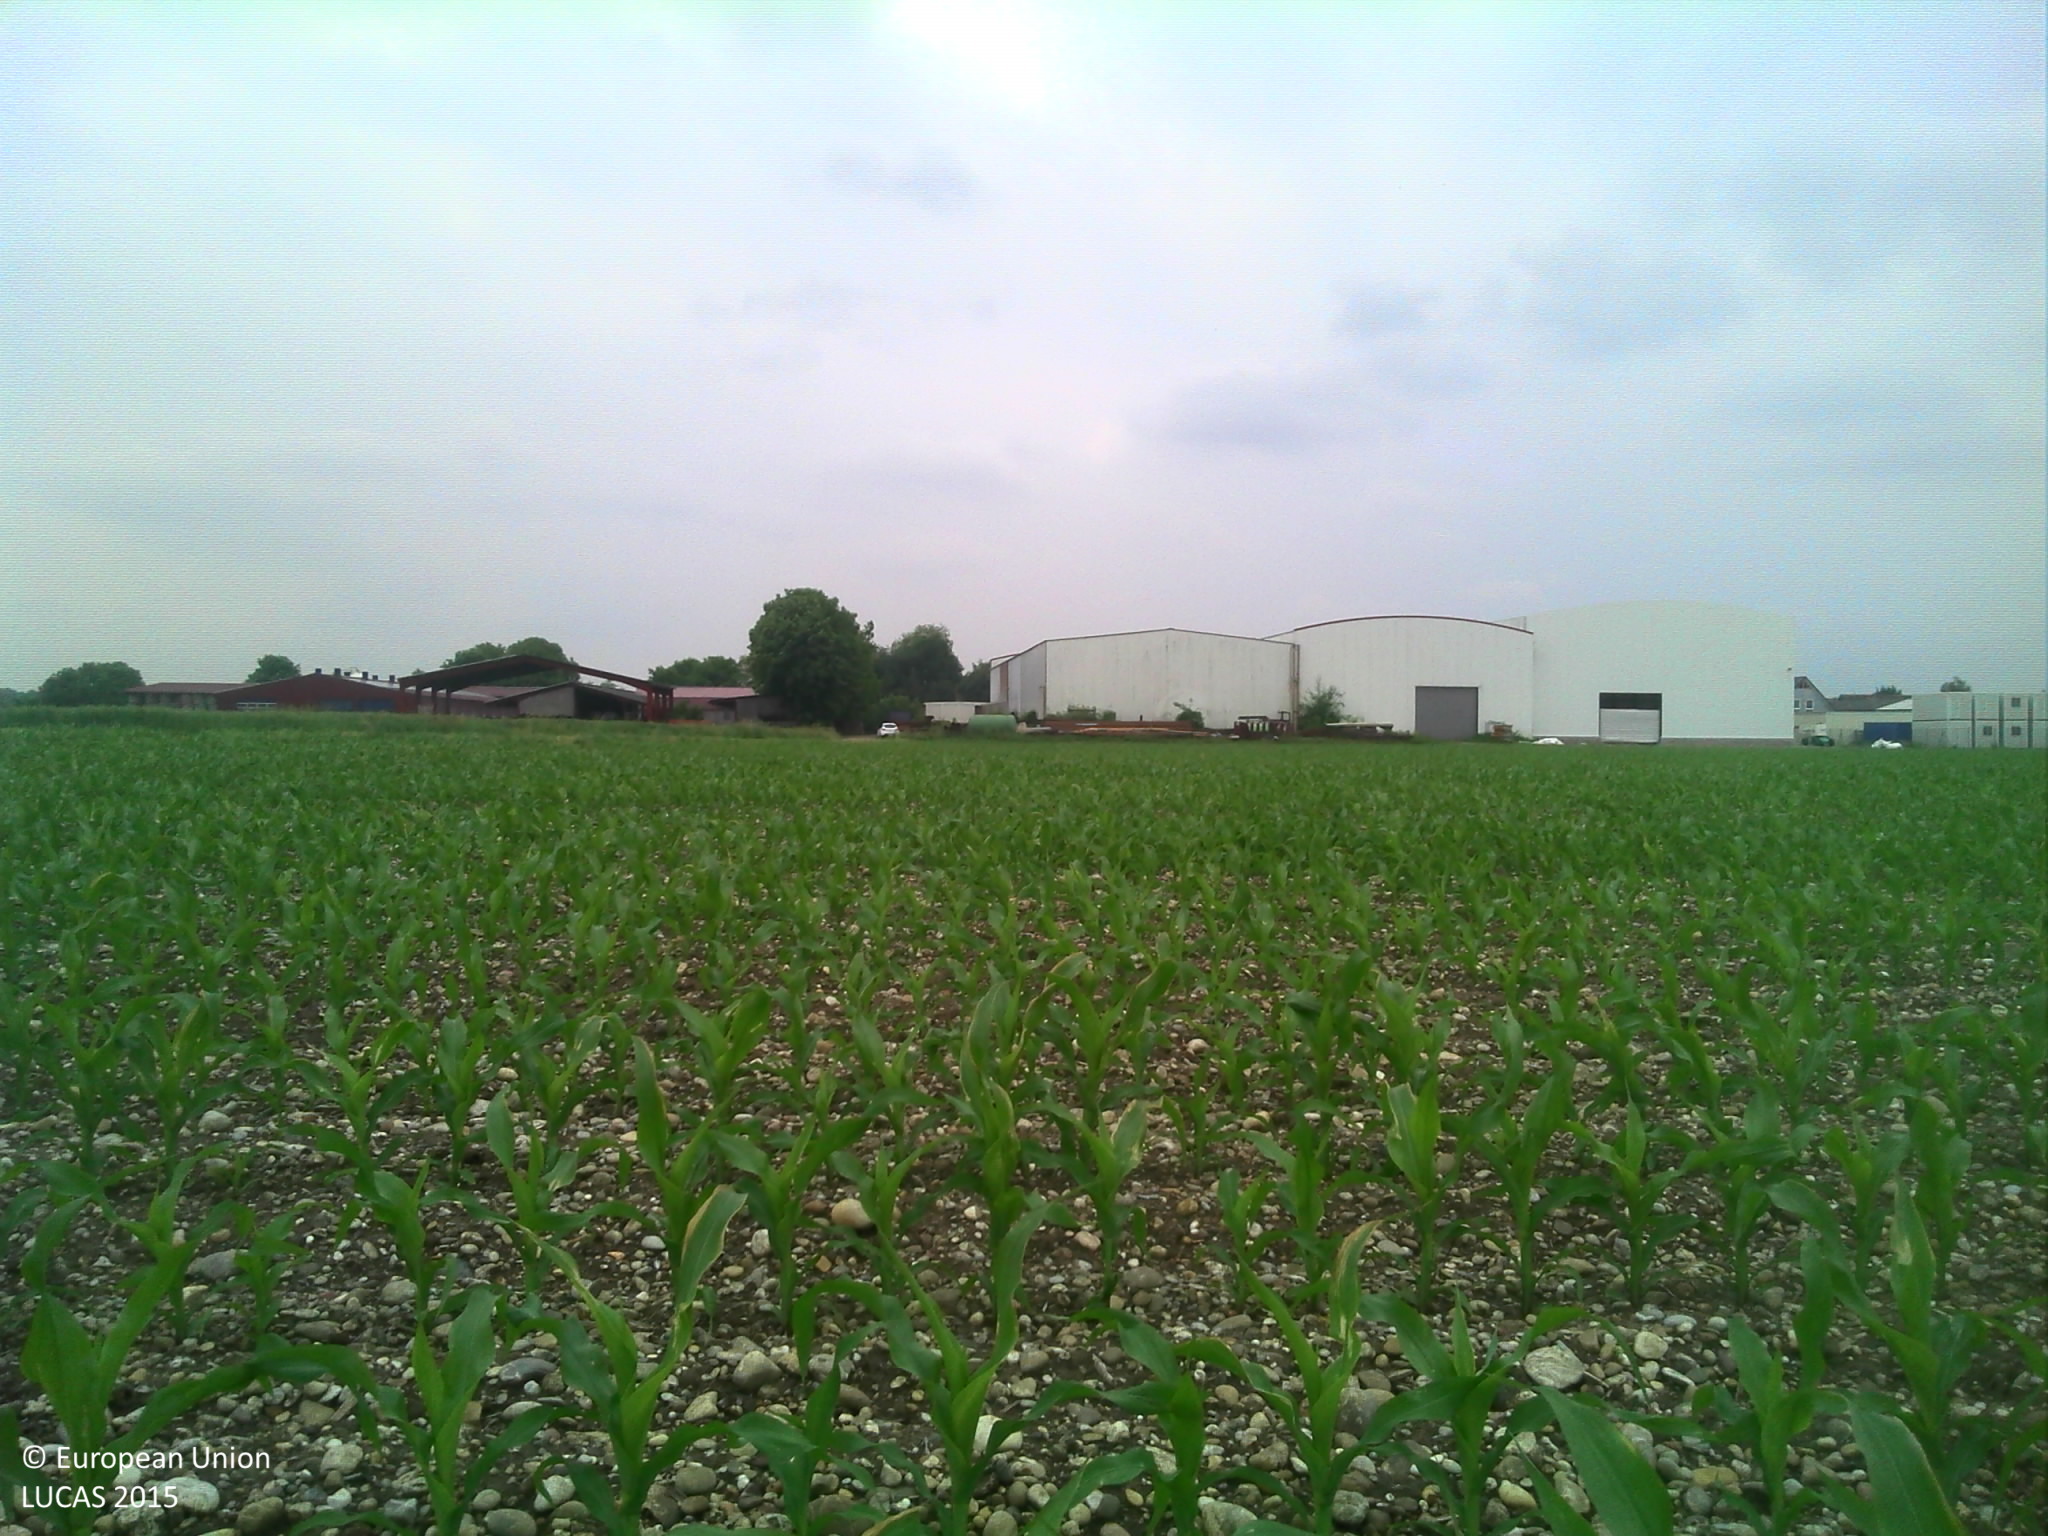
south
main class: Cropland
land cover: Maize
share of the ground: < 10 %
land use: Agriculture (excluding fallow land and kitchen gardens)
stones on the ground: > 50 %
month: May
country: FR
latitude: 48.2878
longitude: 7.6155
